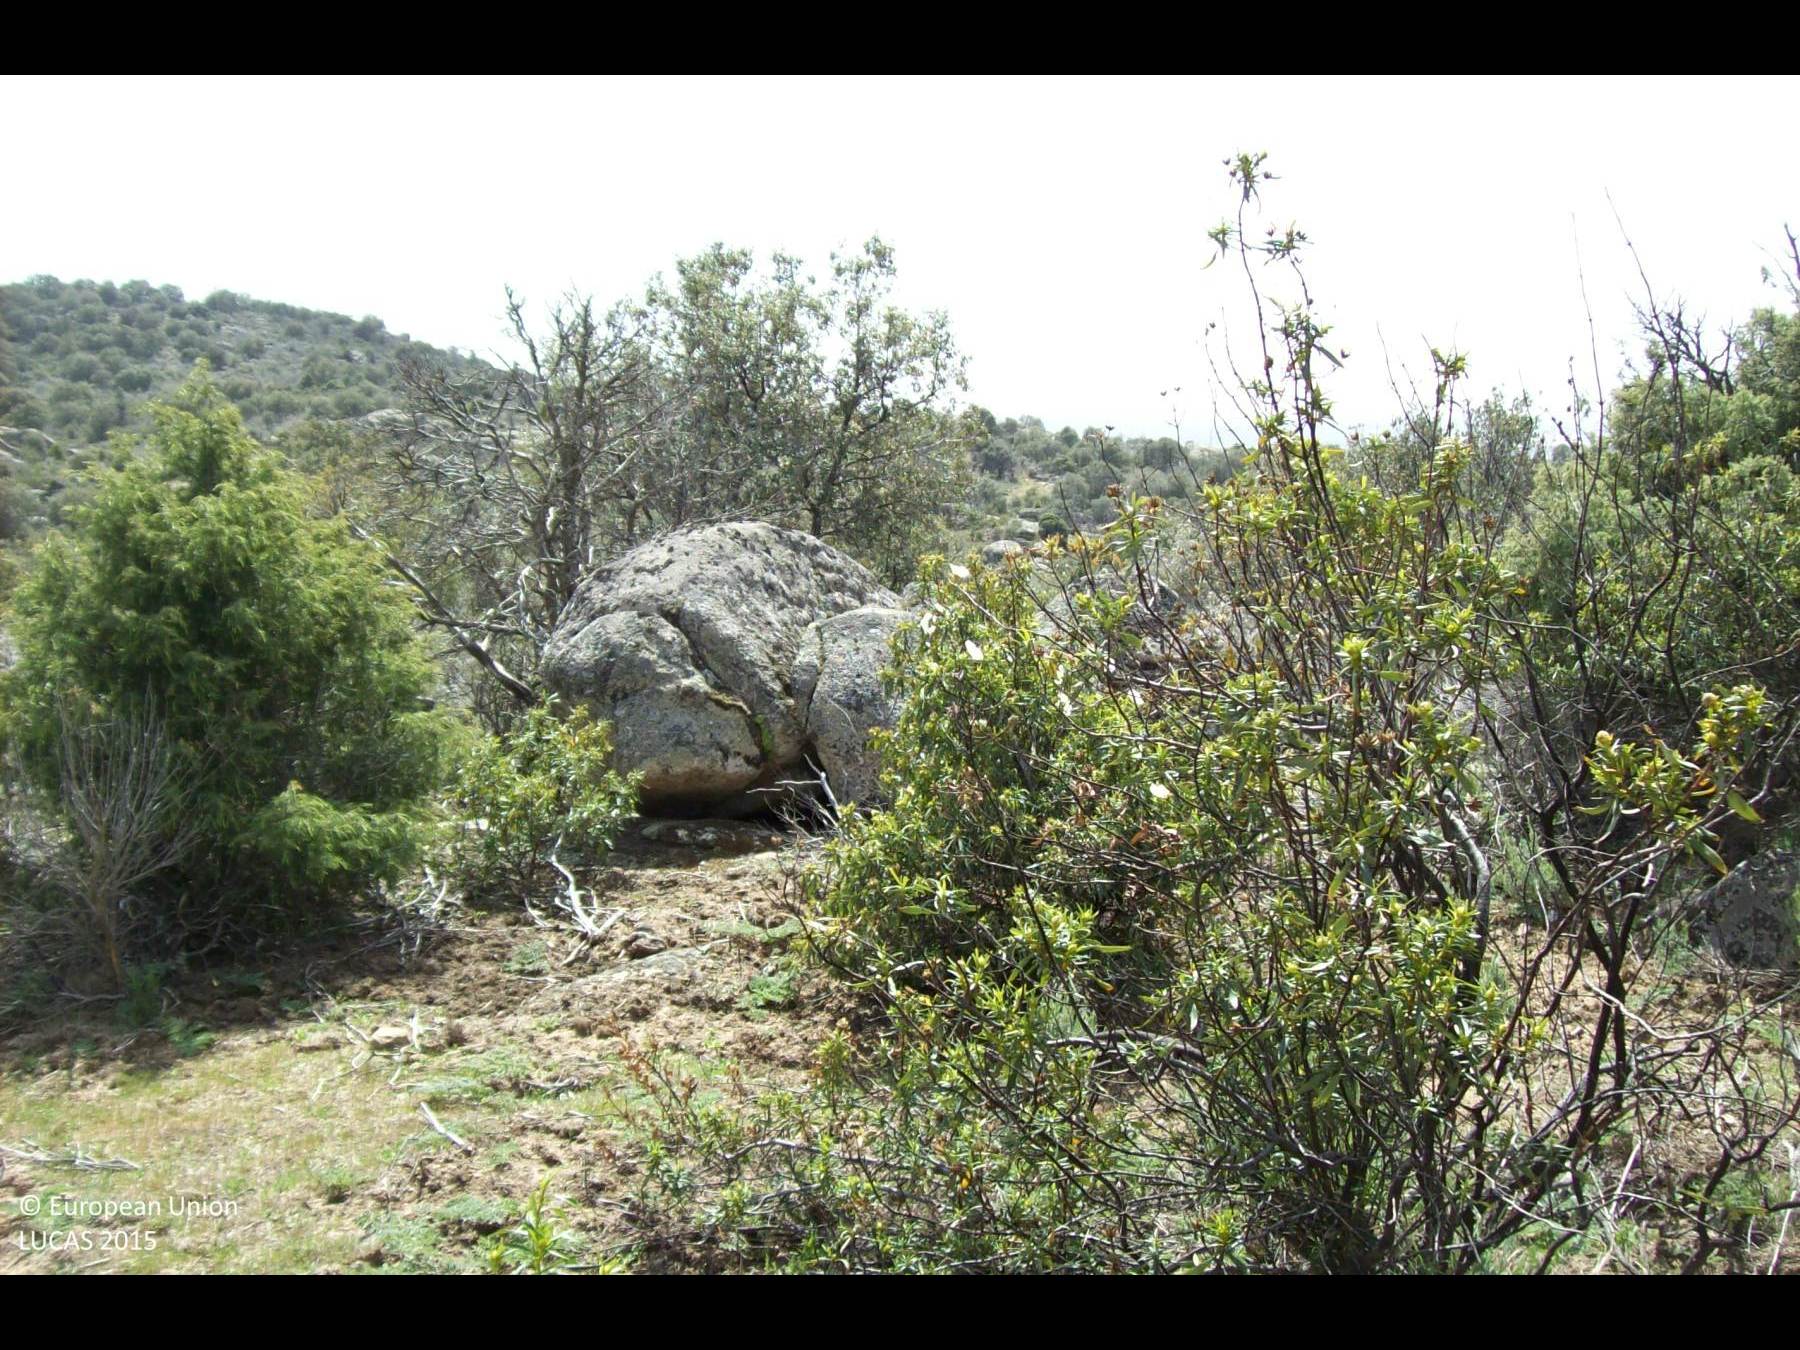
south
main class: Shrubland
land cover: Shrubland with sparse tree cover
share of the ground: > 75 %
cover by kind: consolidated bare surface 40 %, shrubs 35 %, herbaceous plants 20 %, coniferous forest trees 5 %
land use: Semi-natural and natural areas not in use
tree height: < 5 m
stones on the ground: < 10 %
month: April
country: ES
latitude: 40.6381
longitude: -3.9609
